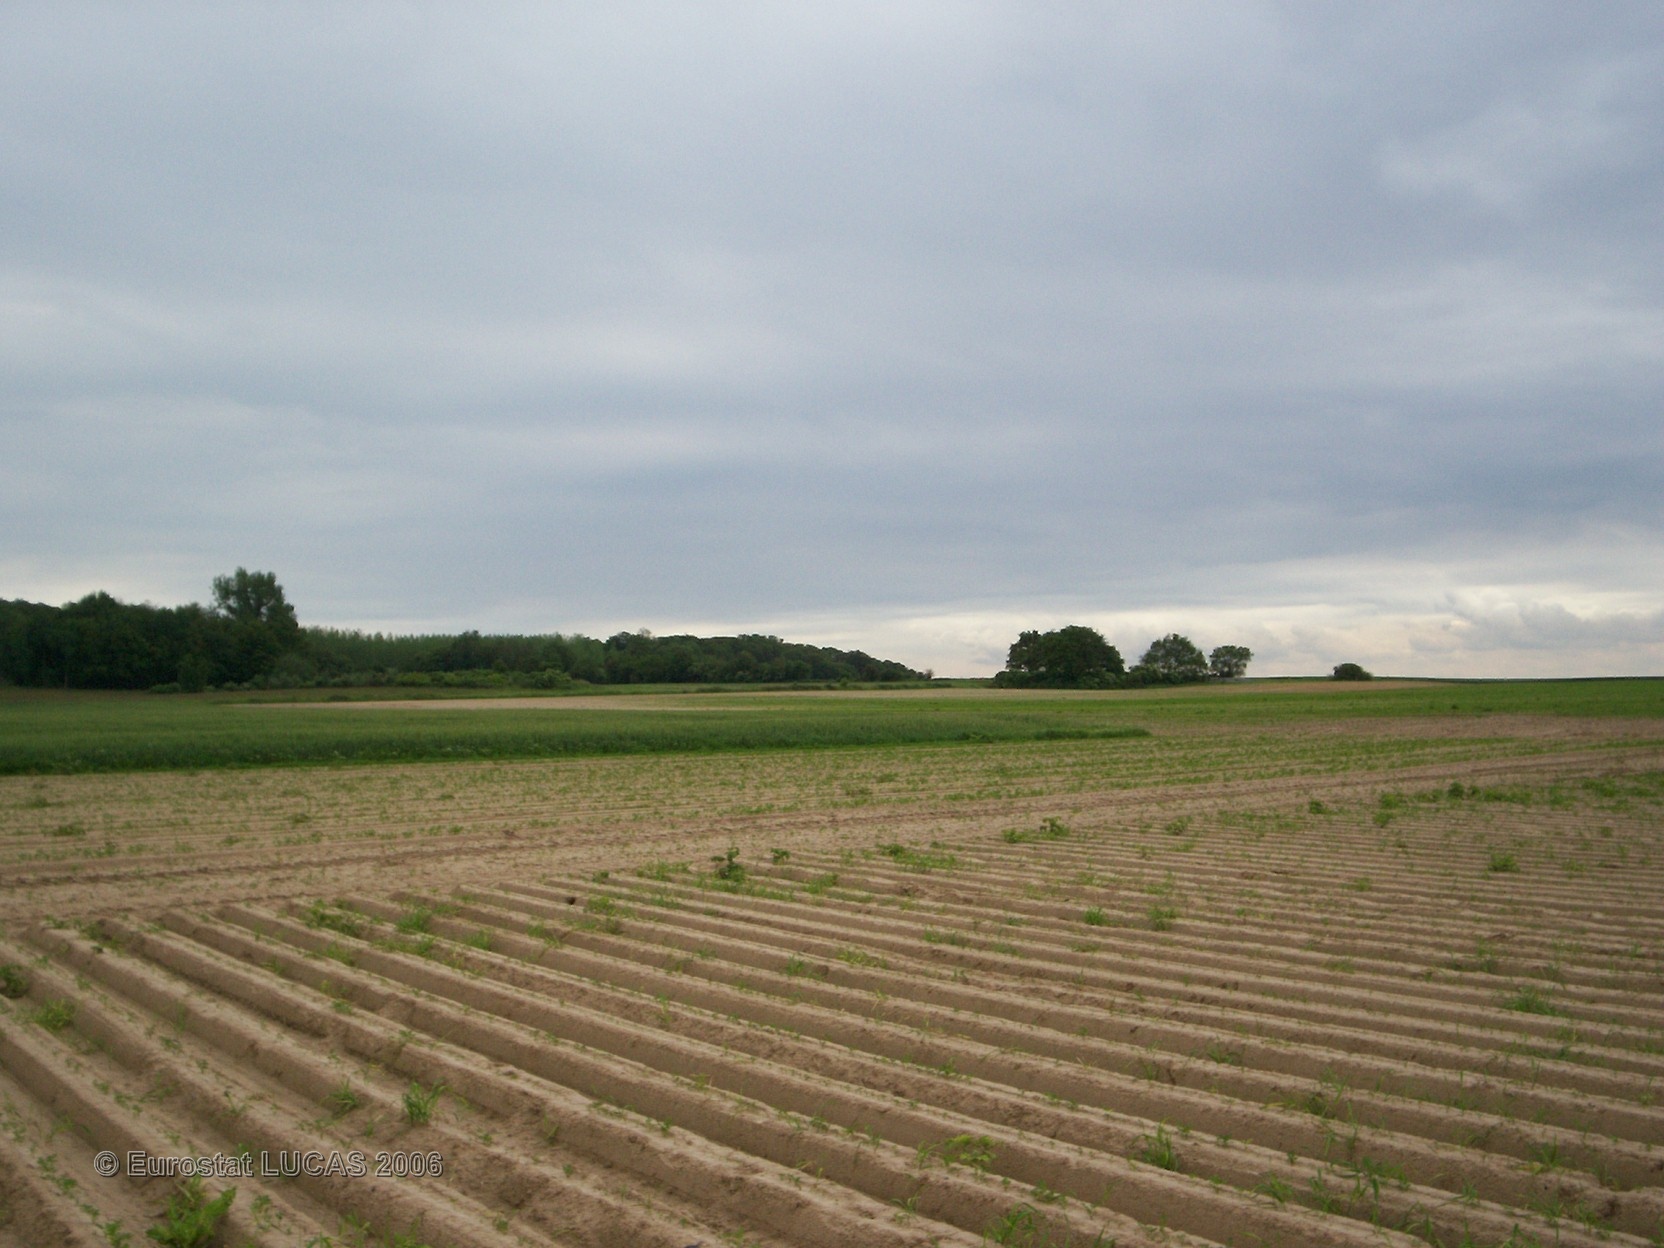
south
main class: Cropland
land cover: Other fresh vegetables
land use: Agriculture (excluding fallow land and kitchen gardens)
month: June
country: FR
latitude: 49.4601
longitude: 2.6628
